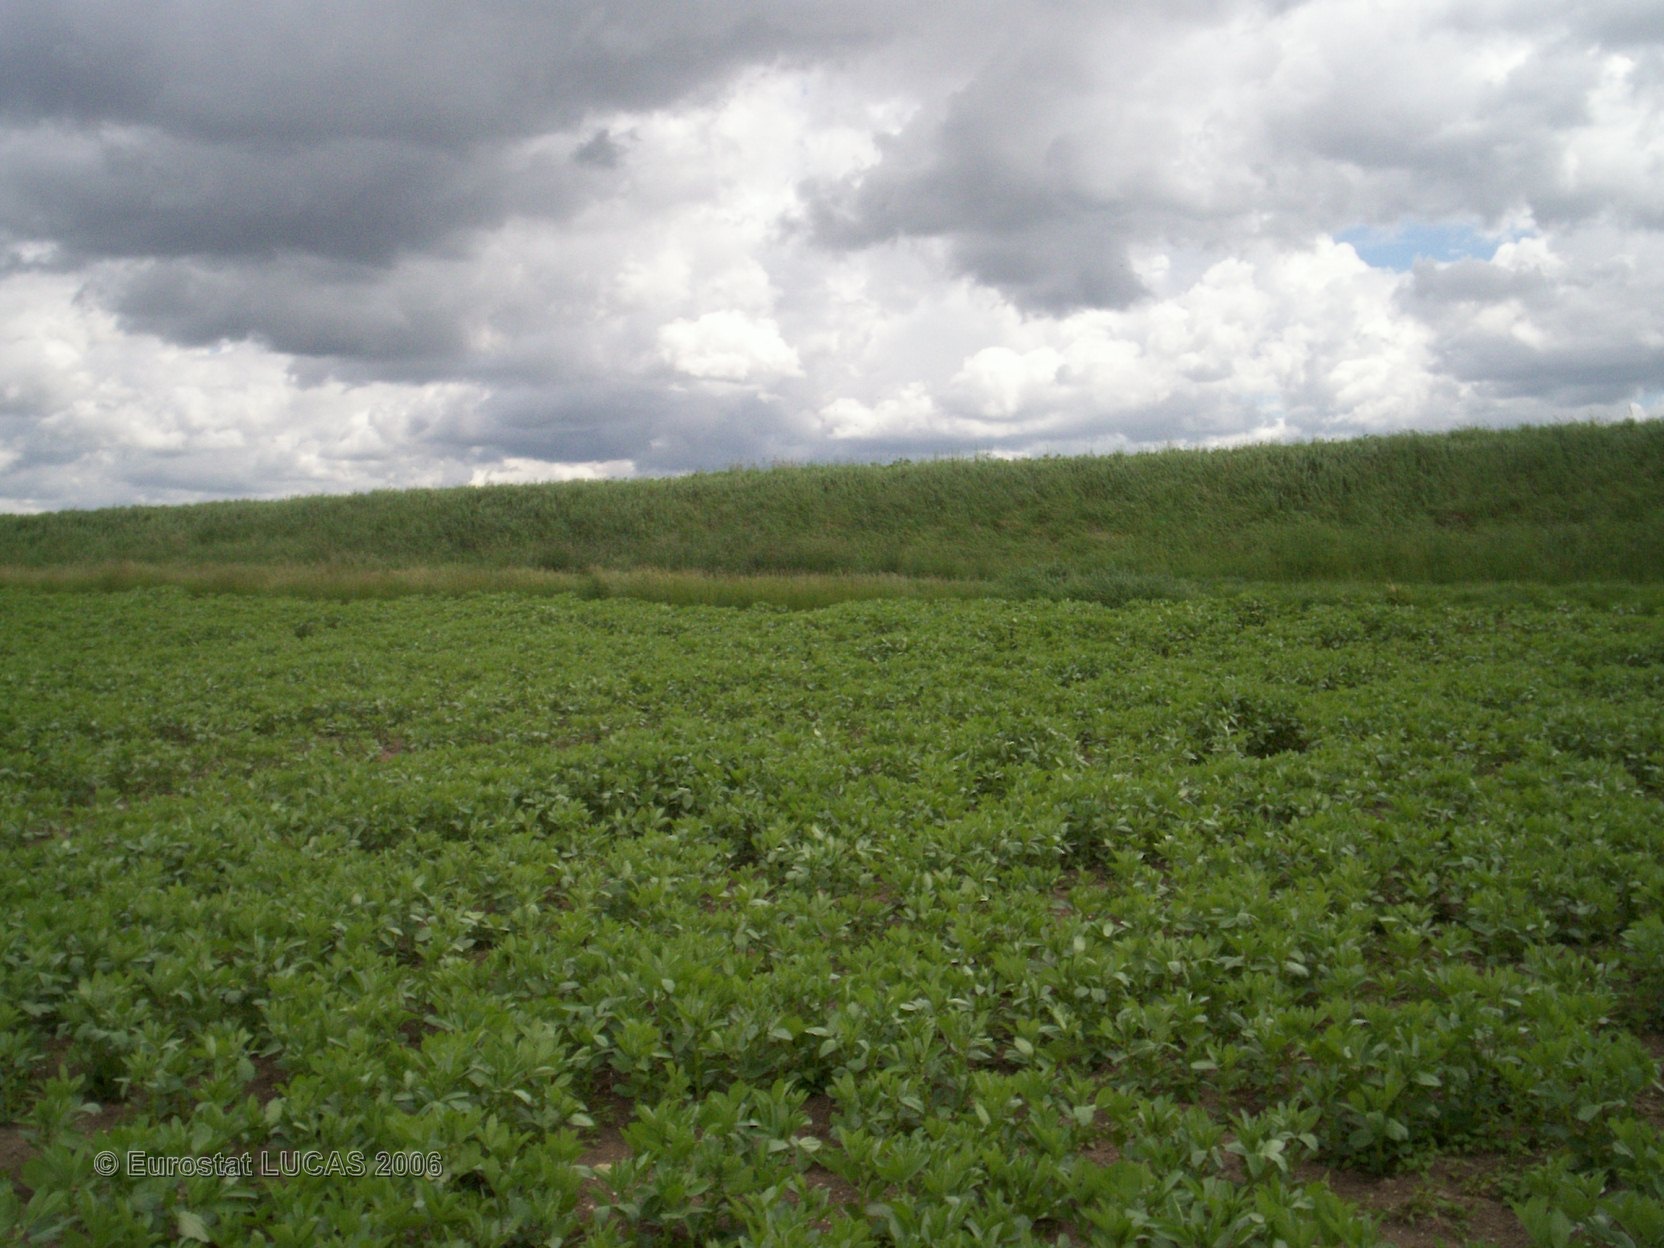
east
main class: Cropland
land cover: Dry pulses
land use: Agriculture (excluding fallow land and kitchen gardens)
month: May
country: FR
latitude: 49.5060
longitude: 4.4031
